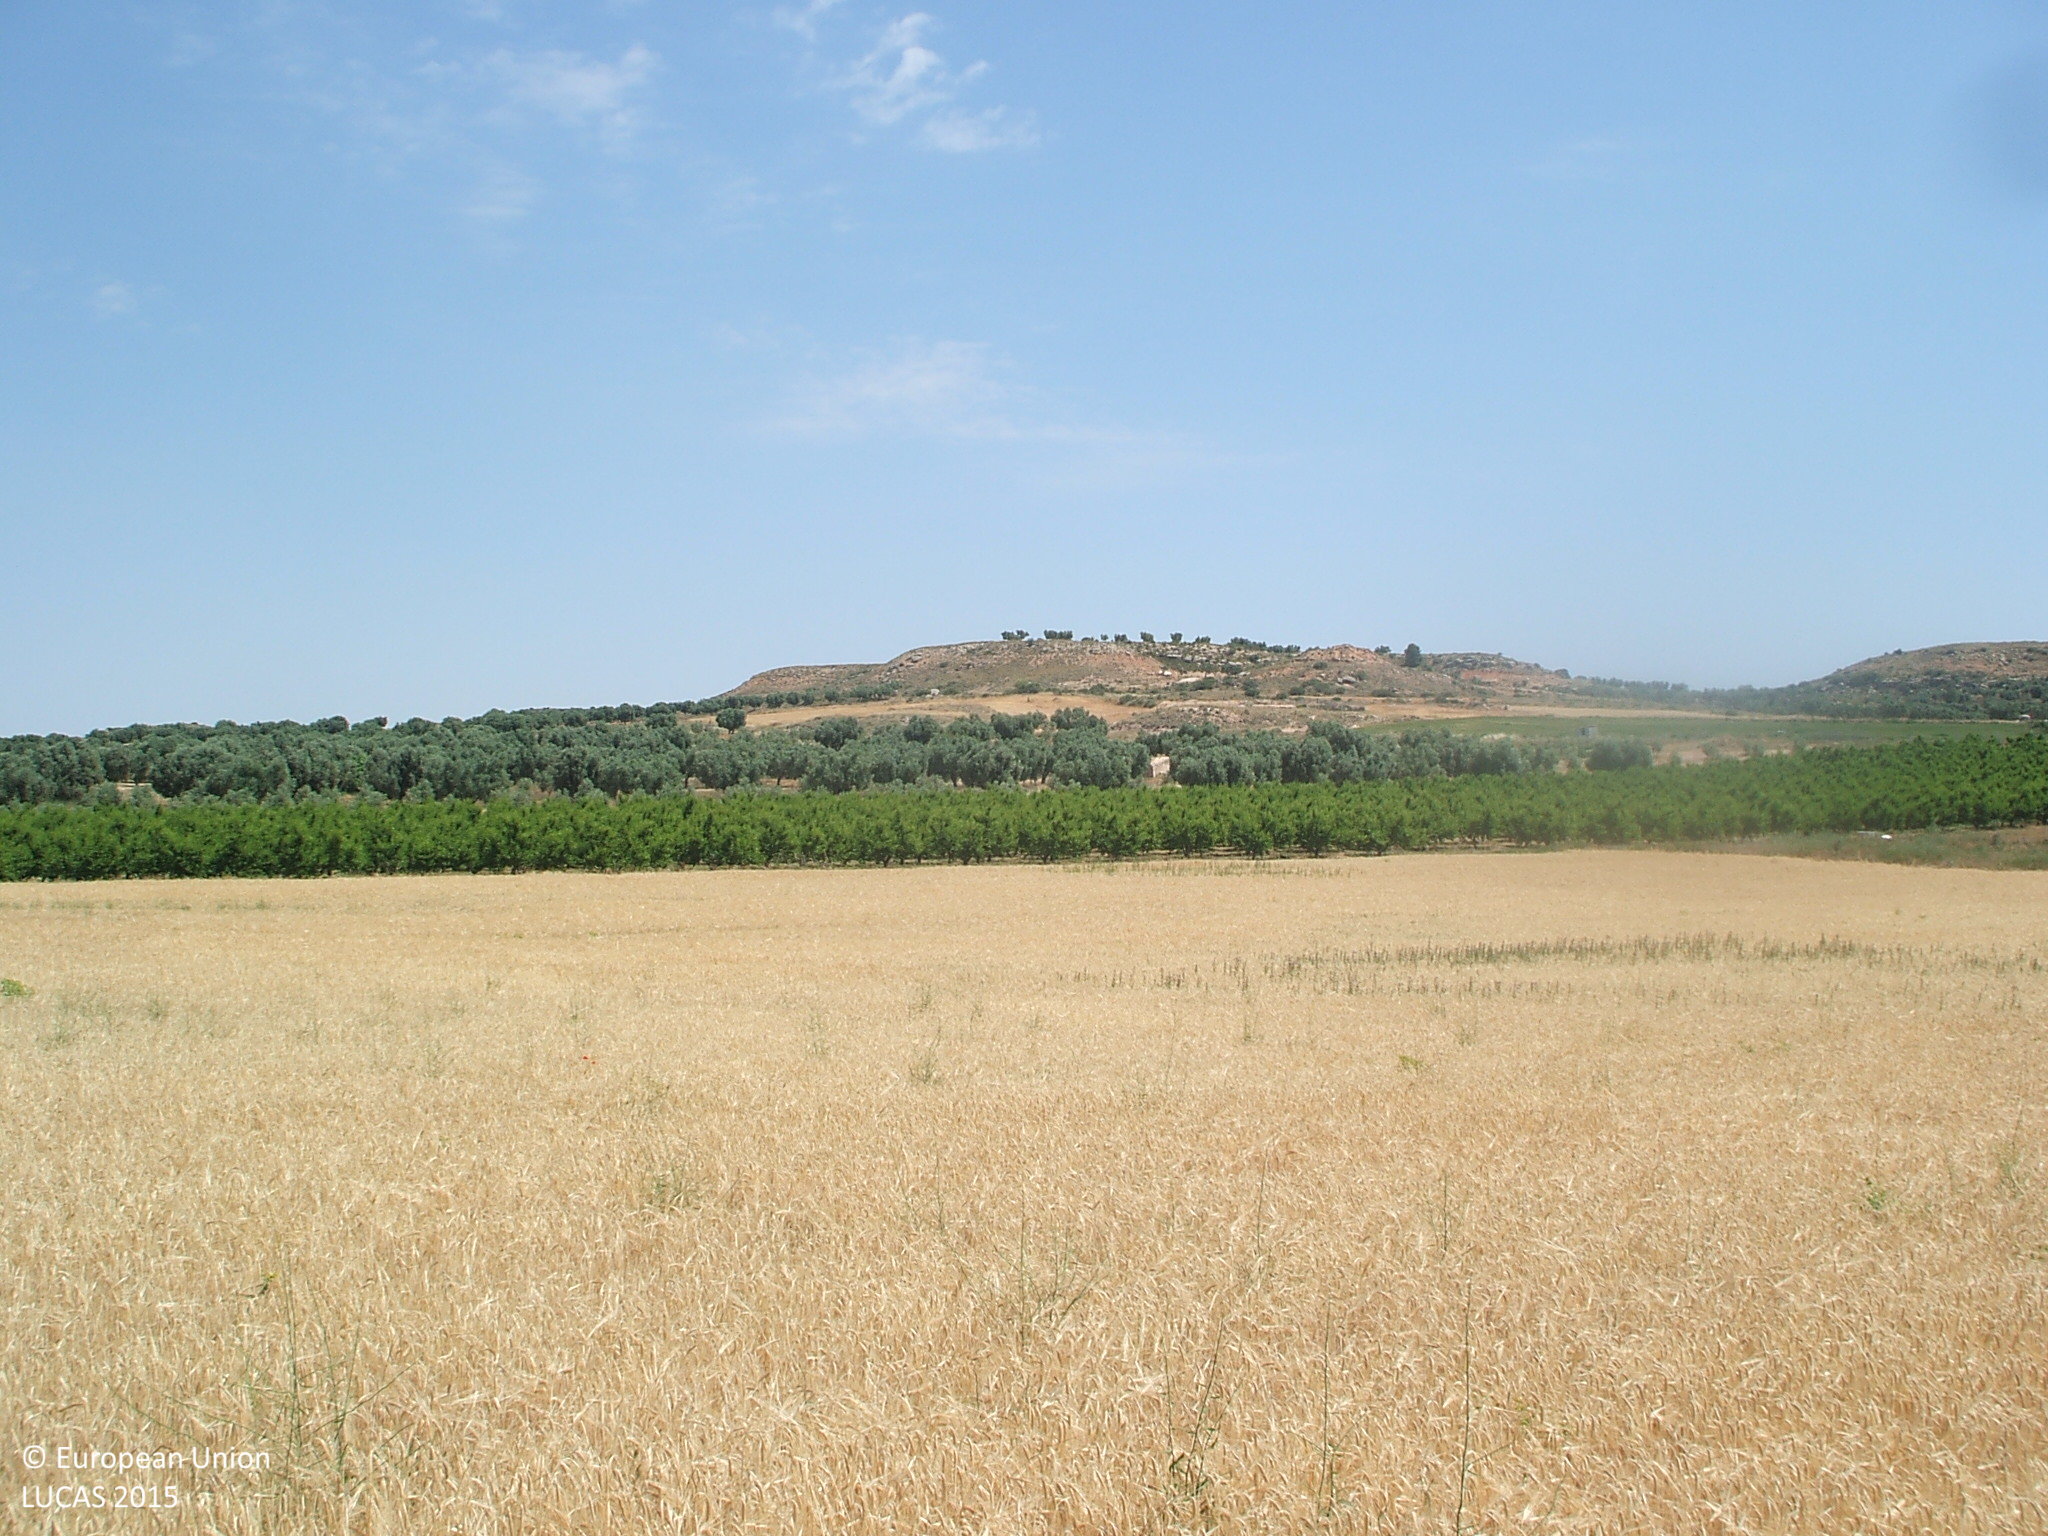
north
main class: Cropland
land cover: Barley
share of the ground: > 75 %
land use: Agriculture (excluding fallow land and kitchen gardens)
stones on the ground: > 50 %
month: June
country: ES
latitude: 40.9760
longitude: -0.1719
